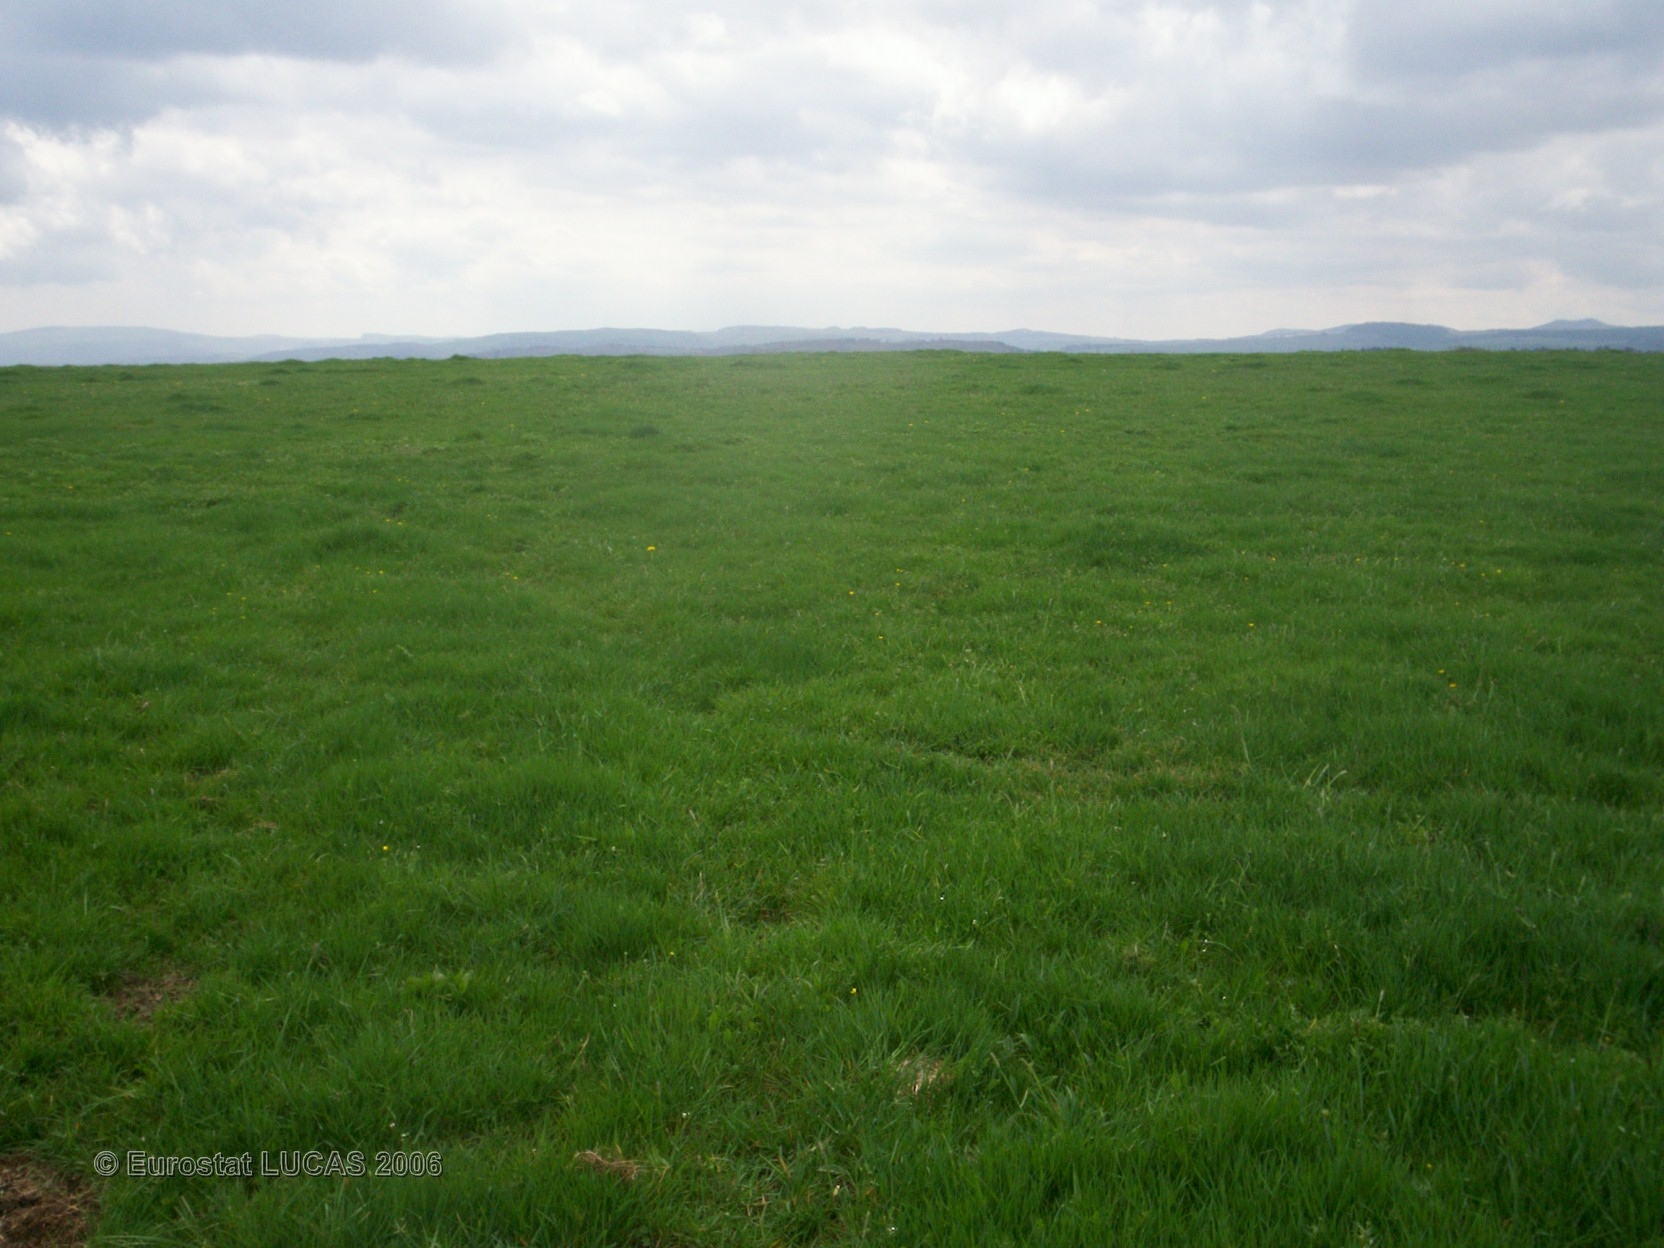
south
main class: Grassland
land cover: Grassland without tree/shrub cover
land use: Agriculture (excluding fallow land and kitchen gardens)
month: April
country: FR
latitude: 45.6129
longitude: 2.9598
